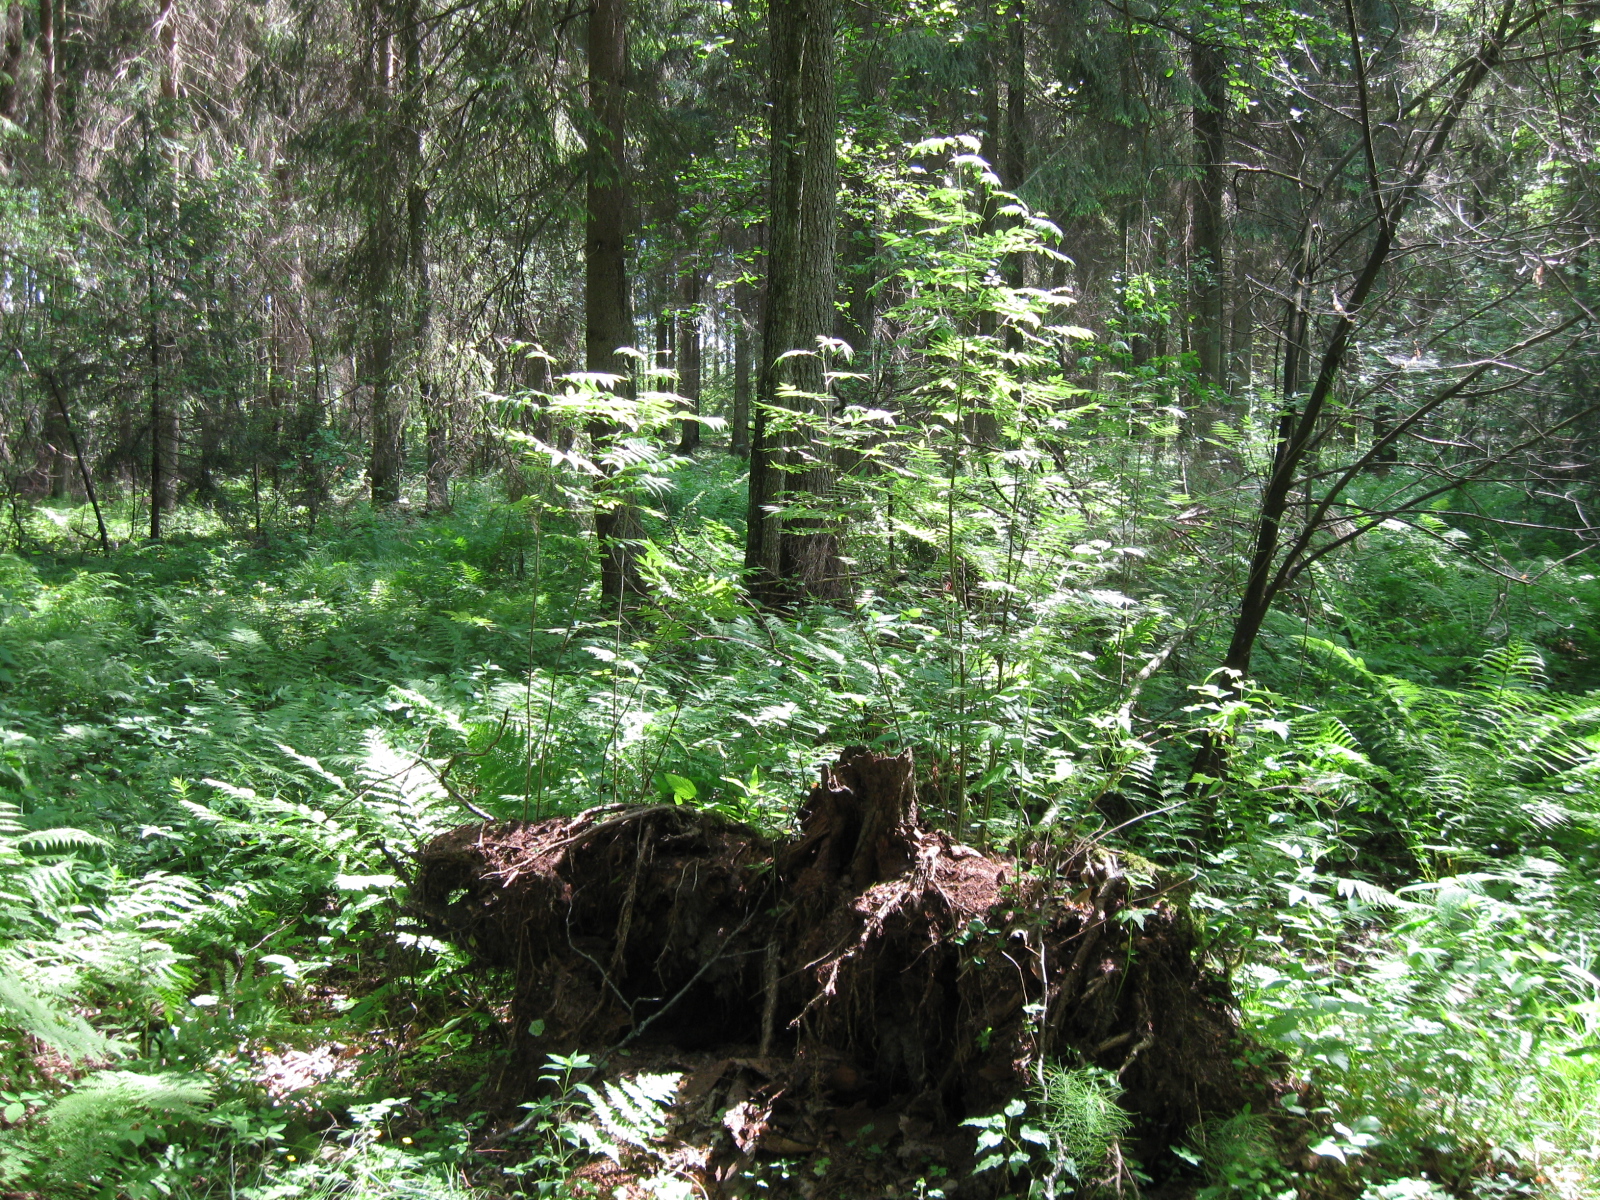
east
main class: Woodland
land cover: Spruce dominated mixed woodland
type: hemiboreal forest and nemoral coniferous forest and mixed broadleaved-coniferous forest
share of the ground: > 75 %
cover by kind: broadleaved forest trees 50 %, coniferous forest trees 45 %, herbaceous plants 5 %
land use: Forestry
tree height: > 5 m
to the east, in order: Spruce dominated mixed woodland; Spontaneously vegetated surfaces
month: June
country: LT
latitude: 54.5809
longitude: 23.7800
